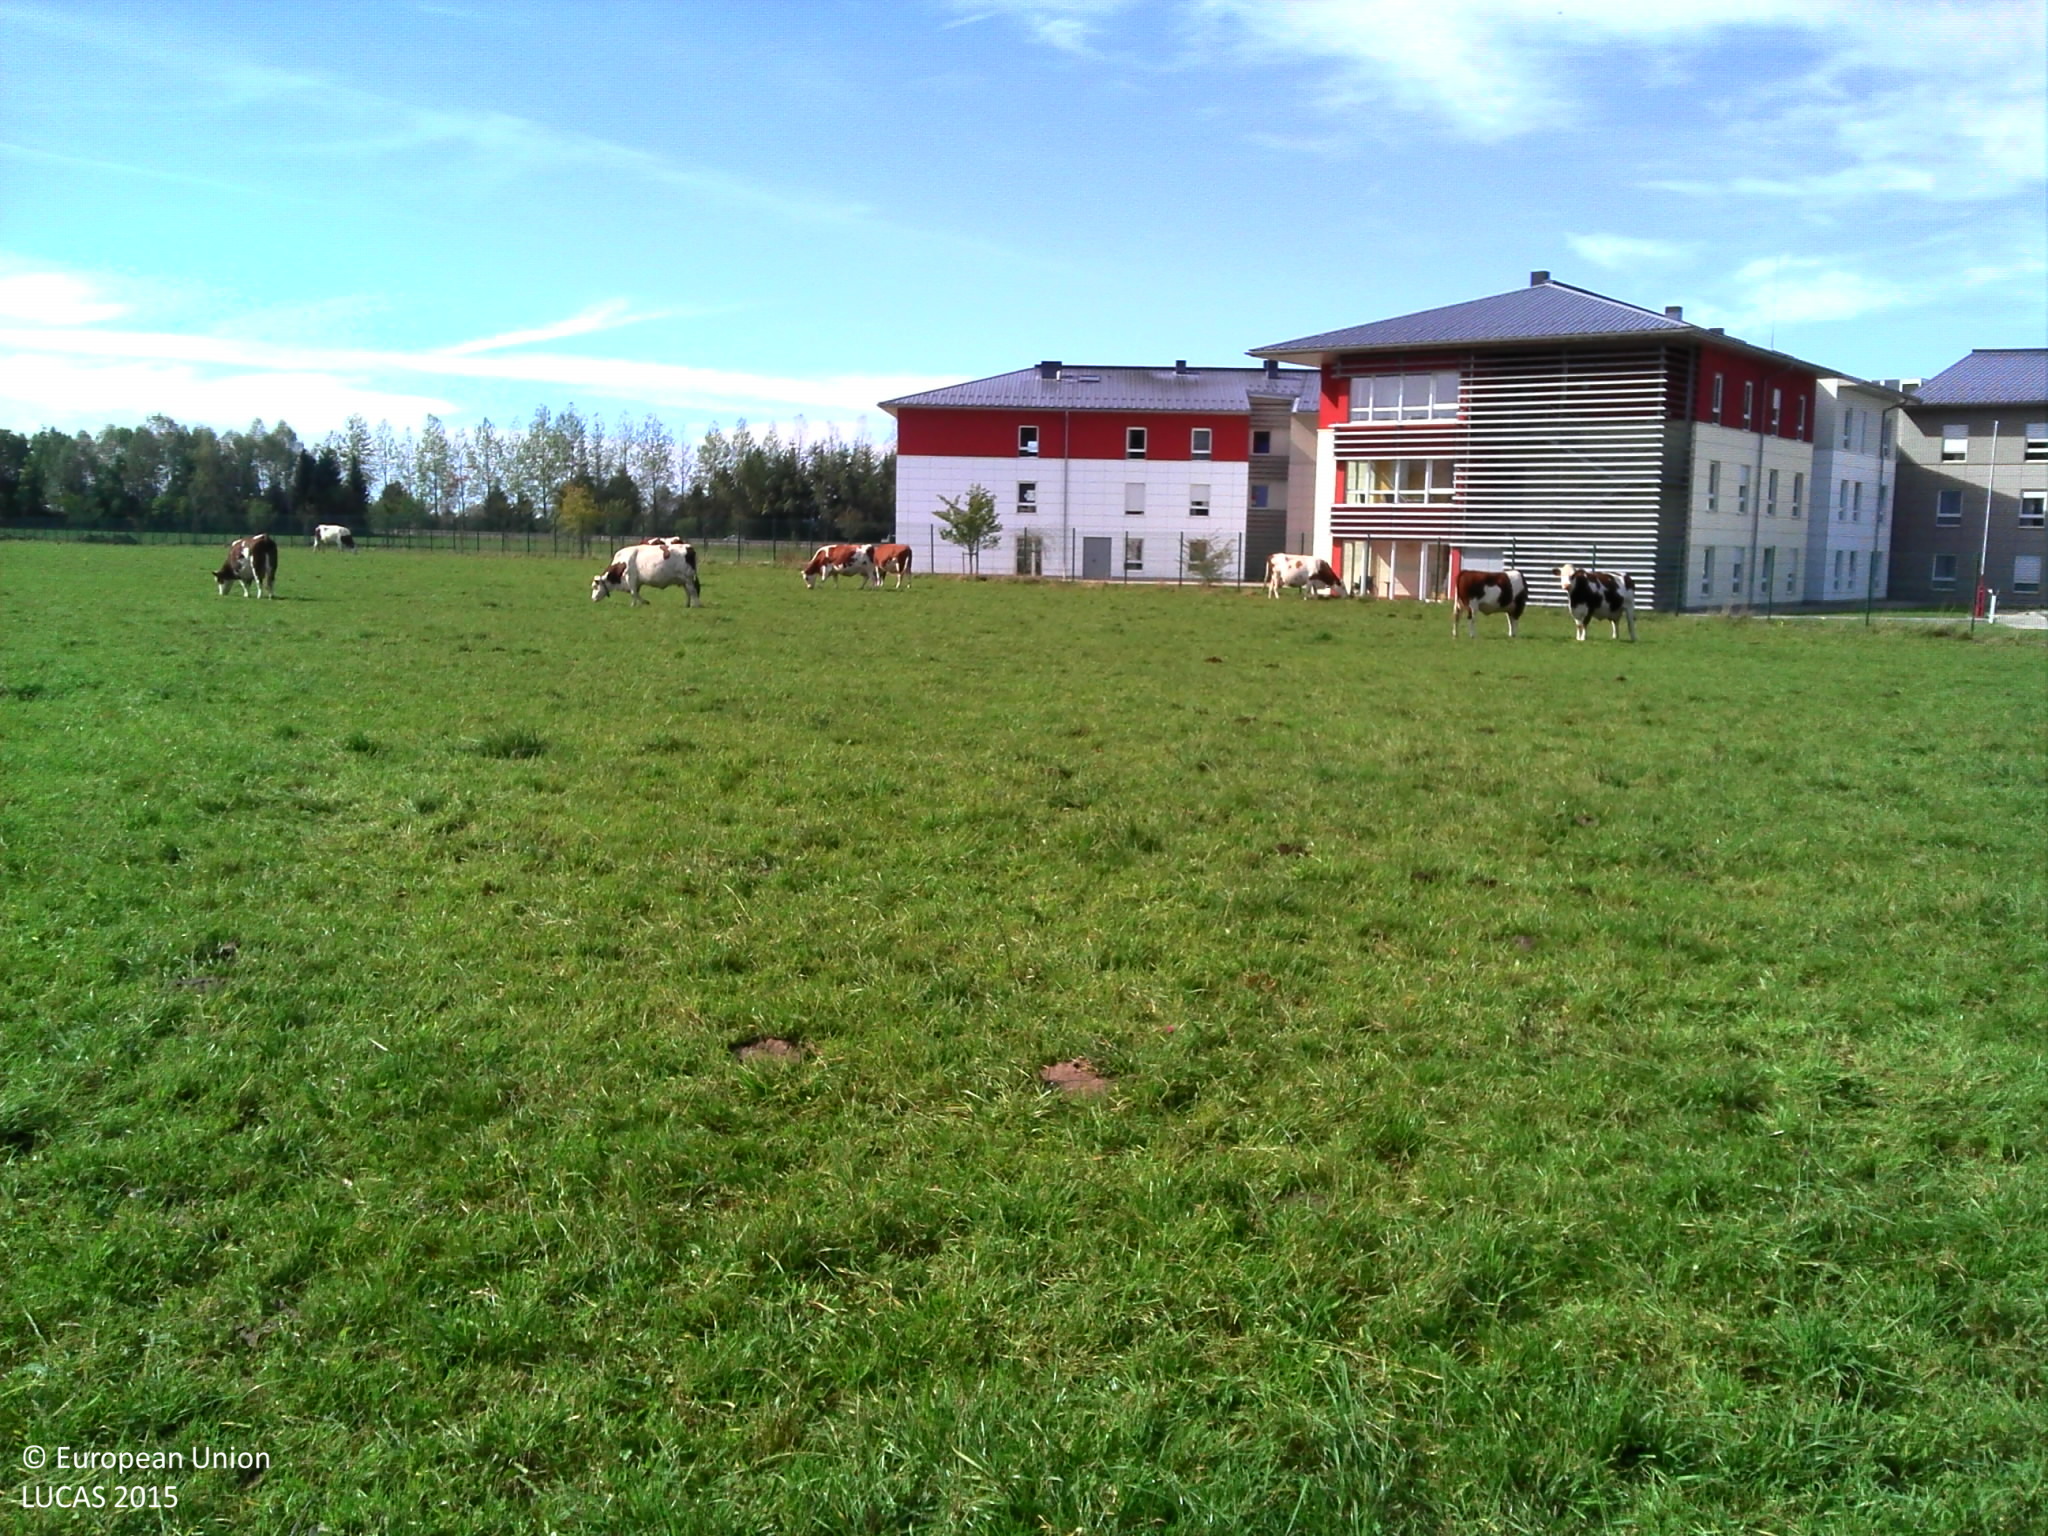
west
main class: Grassland
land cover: Grassland without tree/shrub cover
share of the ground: > 75 %
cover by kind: herbaceous plants 100 %
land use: Agriculture (excluding fallow land and kitchen gardens)
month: October
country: FR
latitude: 46.9195
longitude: 6.3387
